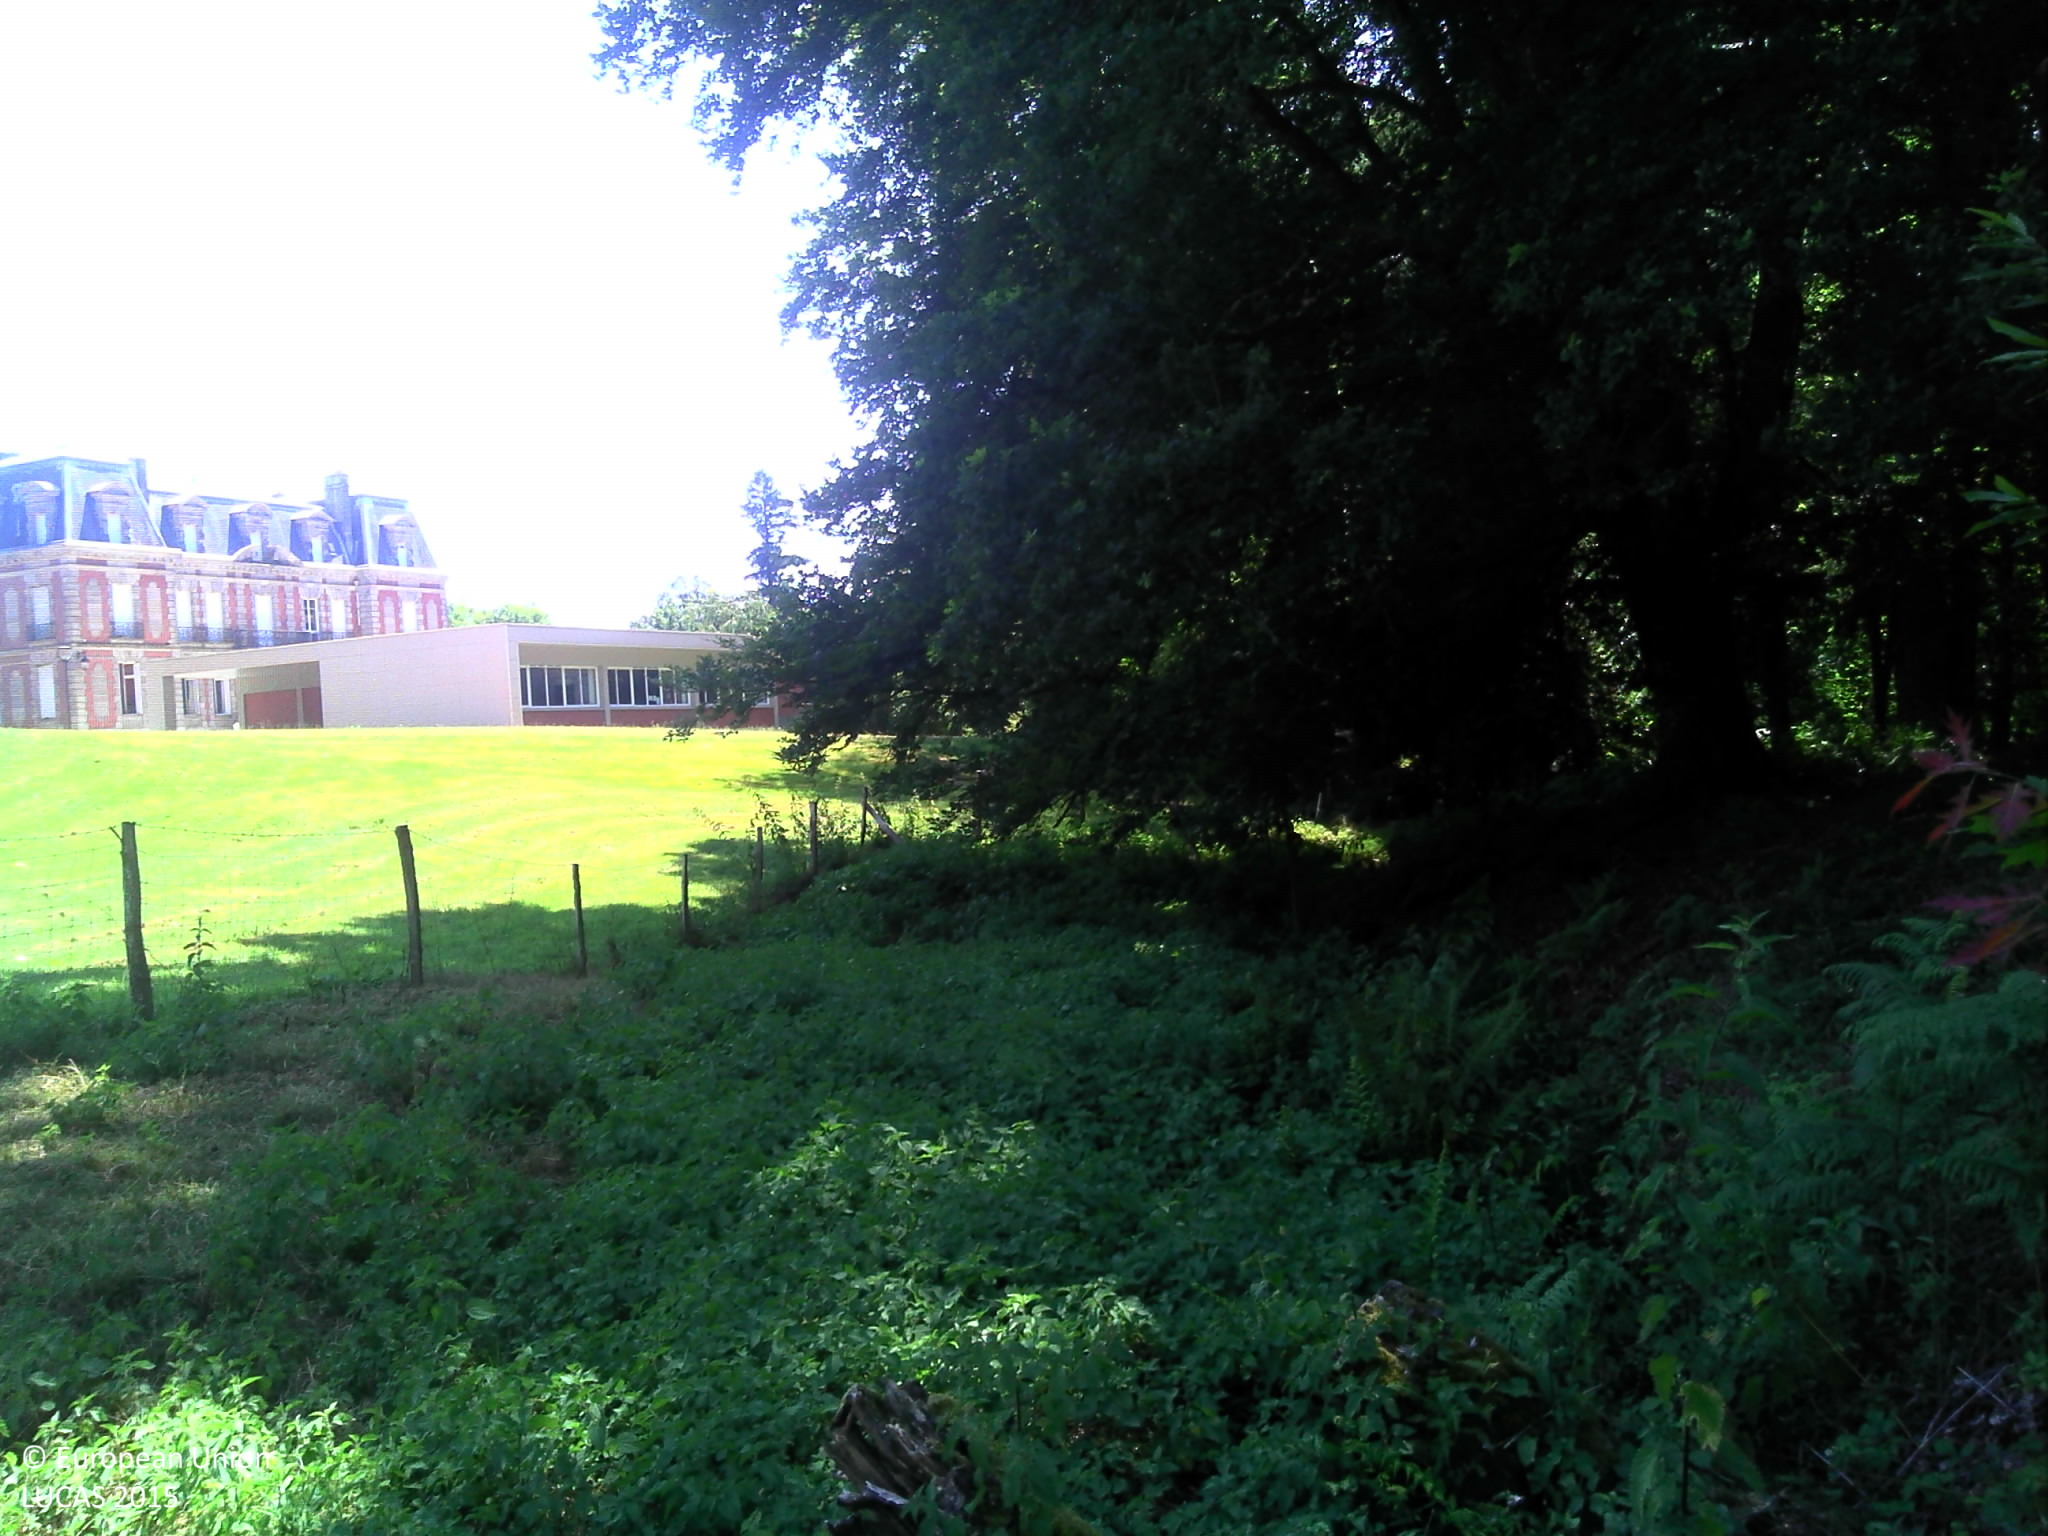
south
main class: Grassland
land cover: Grassland without tree/shrub cover
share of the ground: > 75 %
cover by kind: herbaceous plants 95 %, shrubs 5 %
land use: Community services
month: July
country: FR
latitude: 46.1344
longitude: 1.6692
